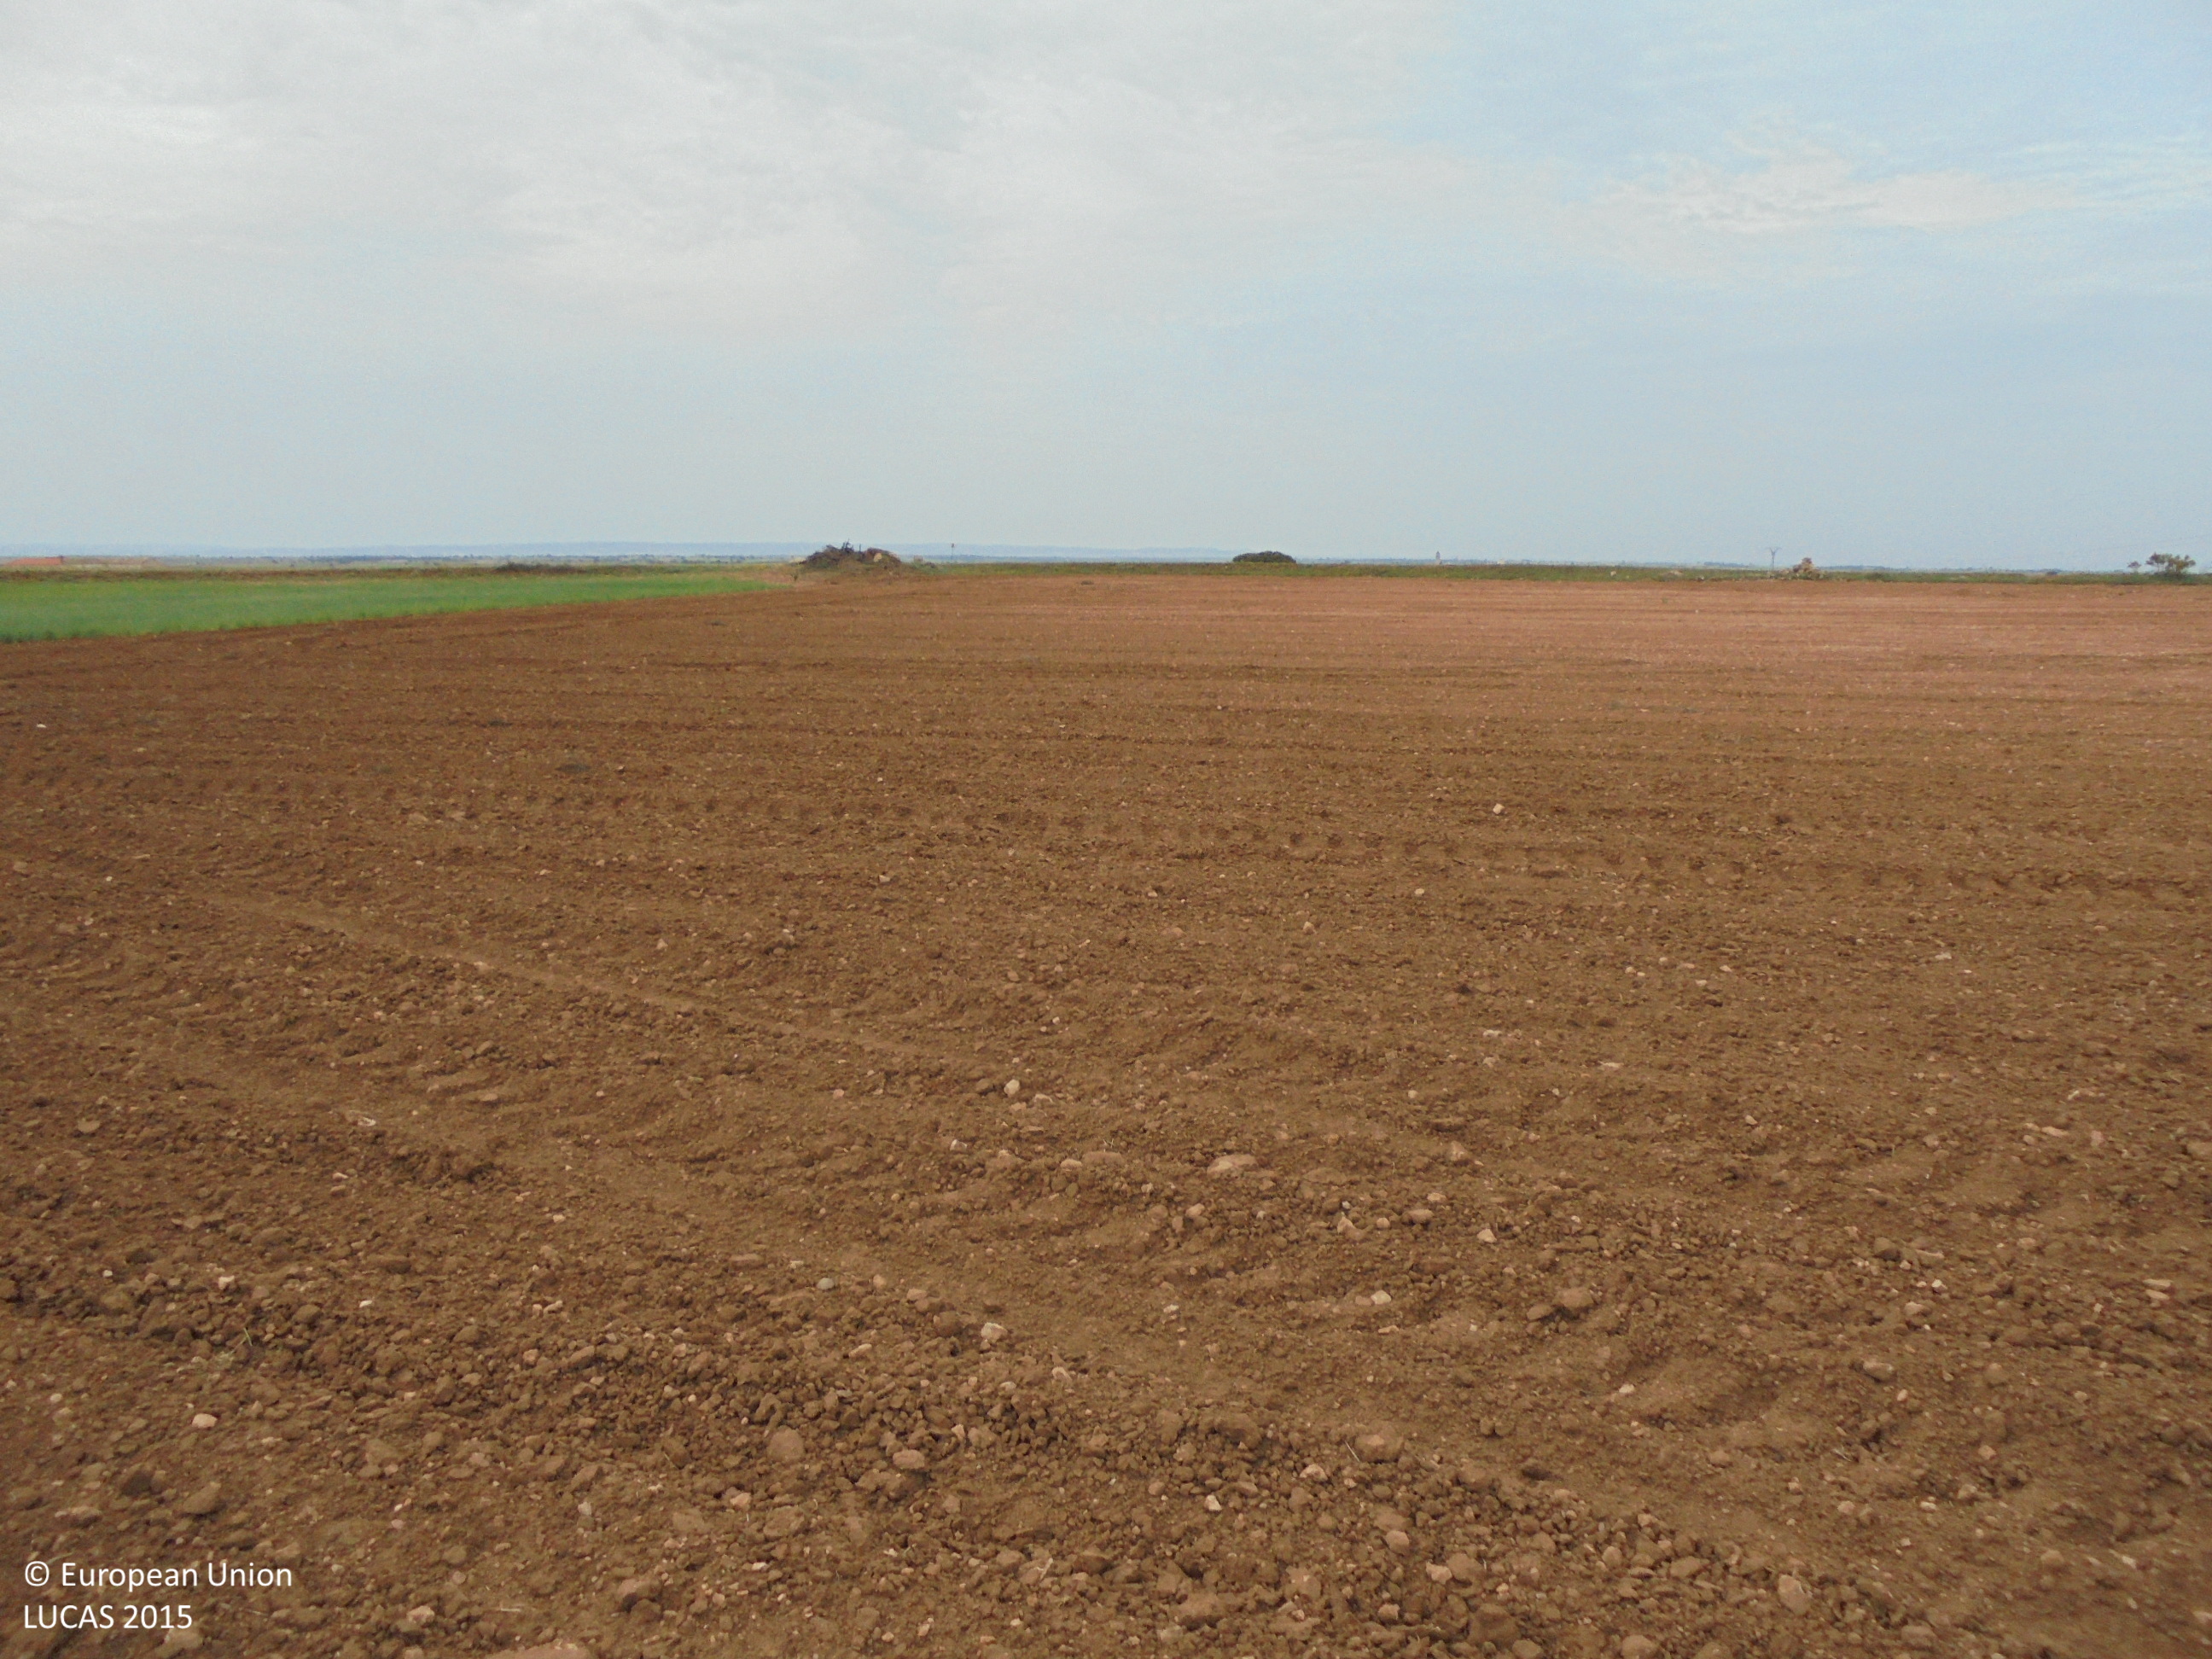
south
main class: Cropland
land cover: Durum wheat
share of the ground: > 75 %
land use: Agriculture (excluding fallow land and kitchen gardens)
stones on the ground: 10 - 25 %
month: May
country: ES
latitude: 39.2520
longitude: -1.7180
